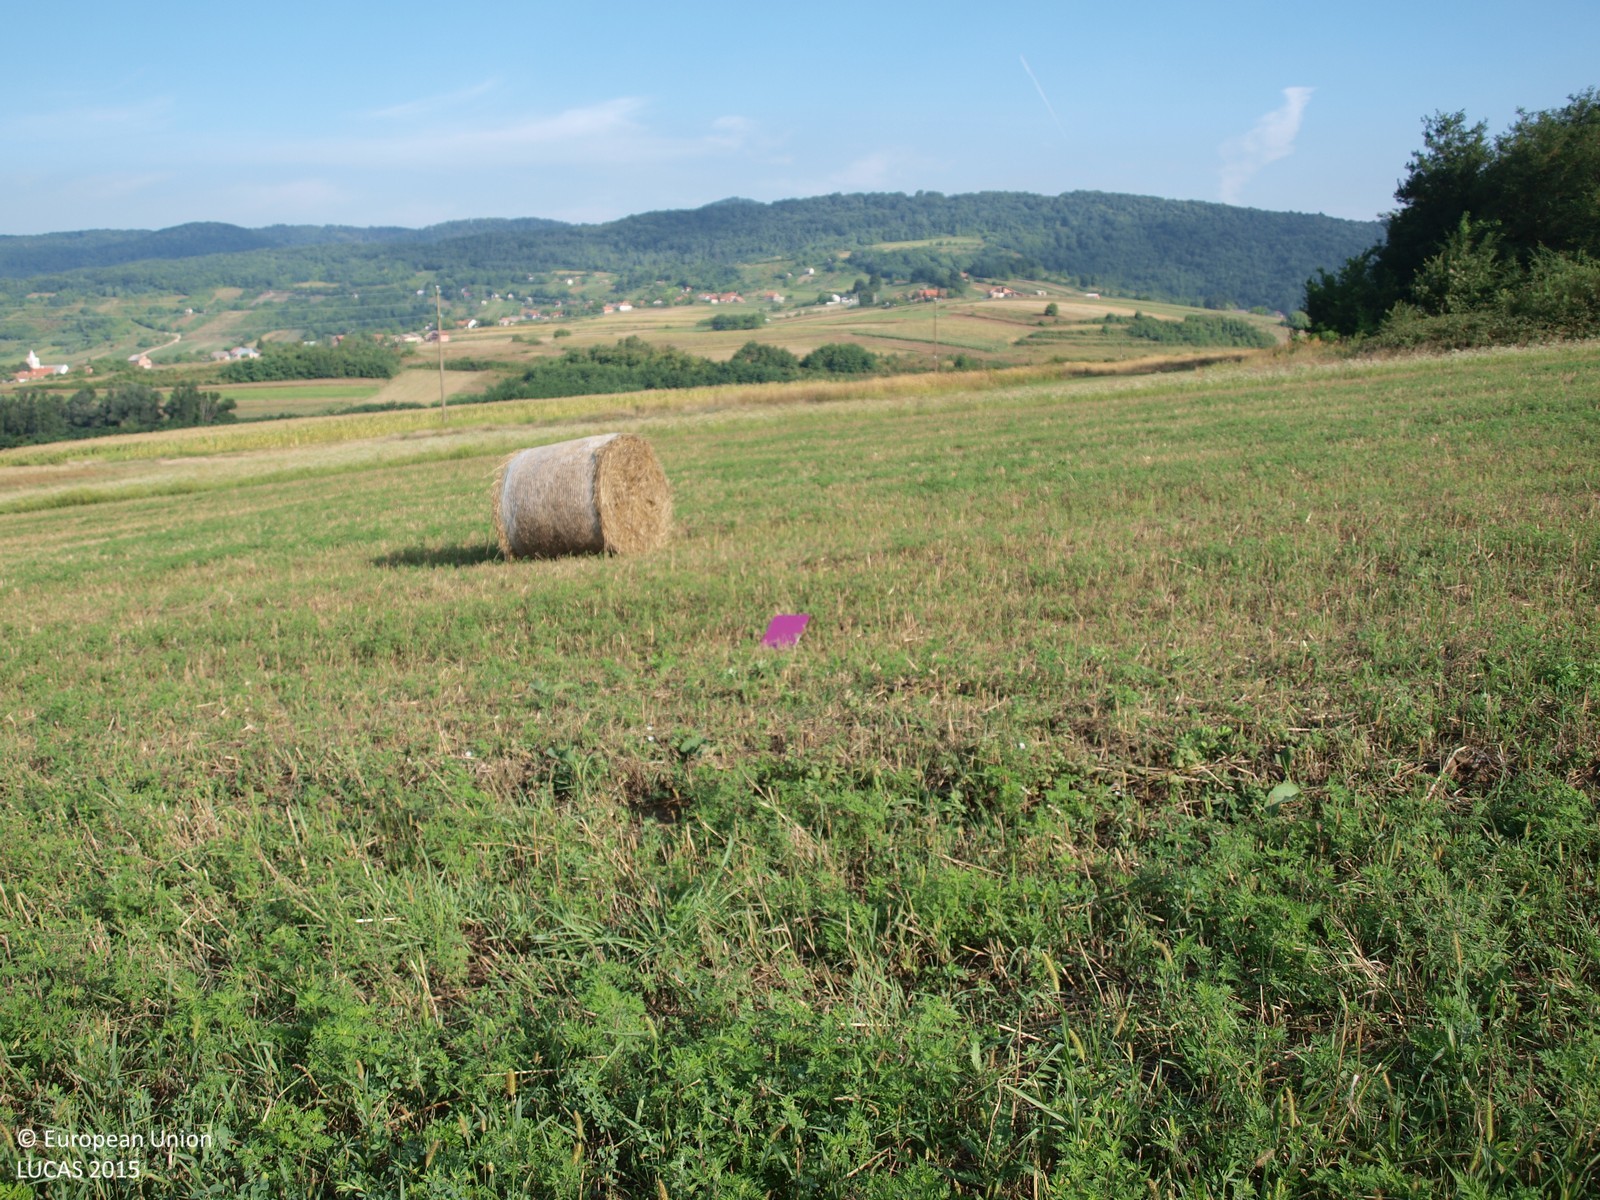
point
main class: Cropland
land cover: Oats
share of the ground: > 75 %
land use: Agriculture (excluding fallow land and kitchen gardens)
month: August
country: HR
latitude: 46.1051
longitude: 16.4035
